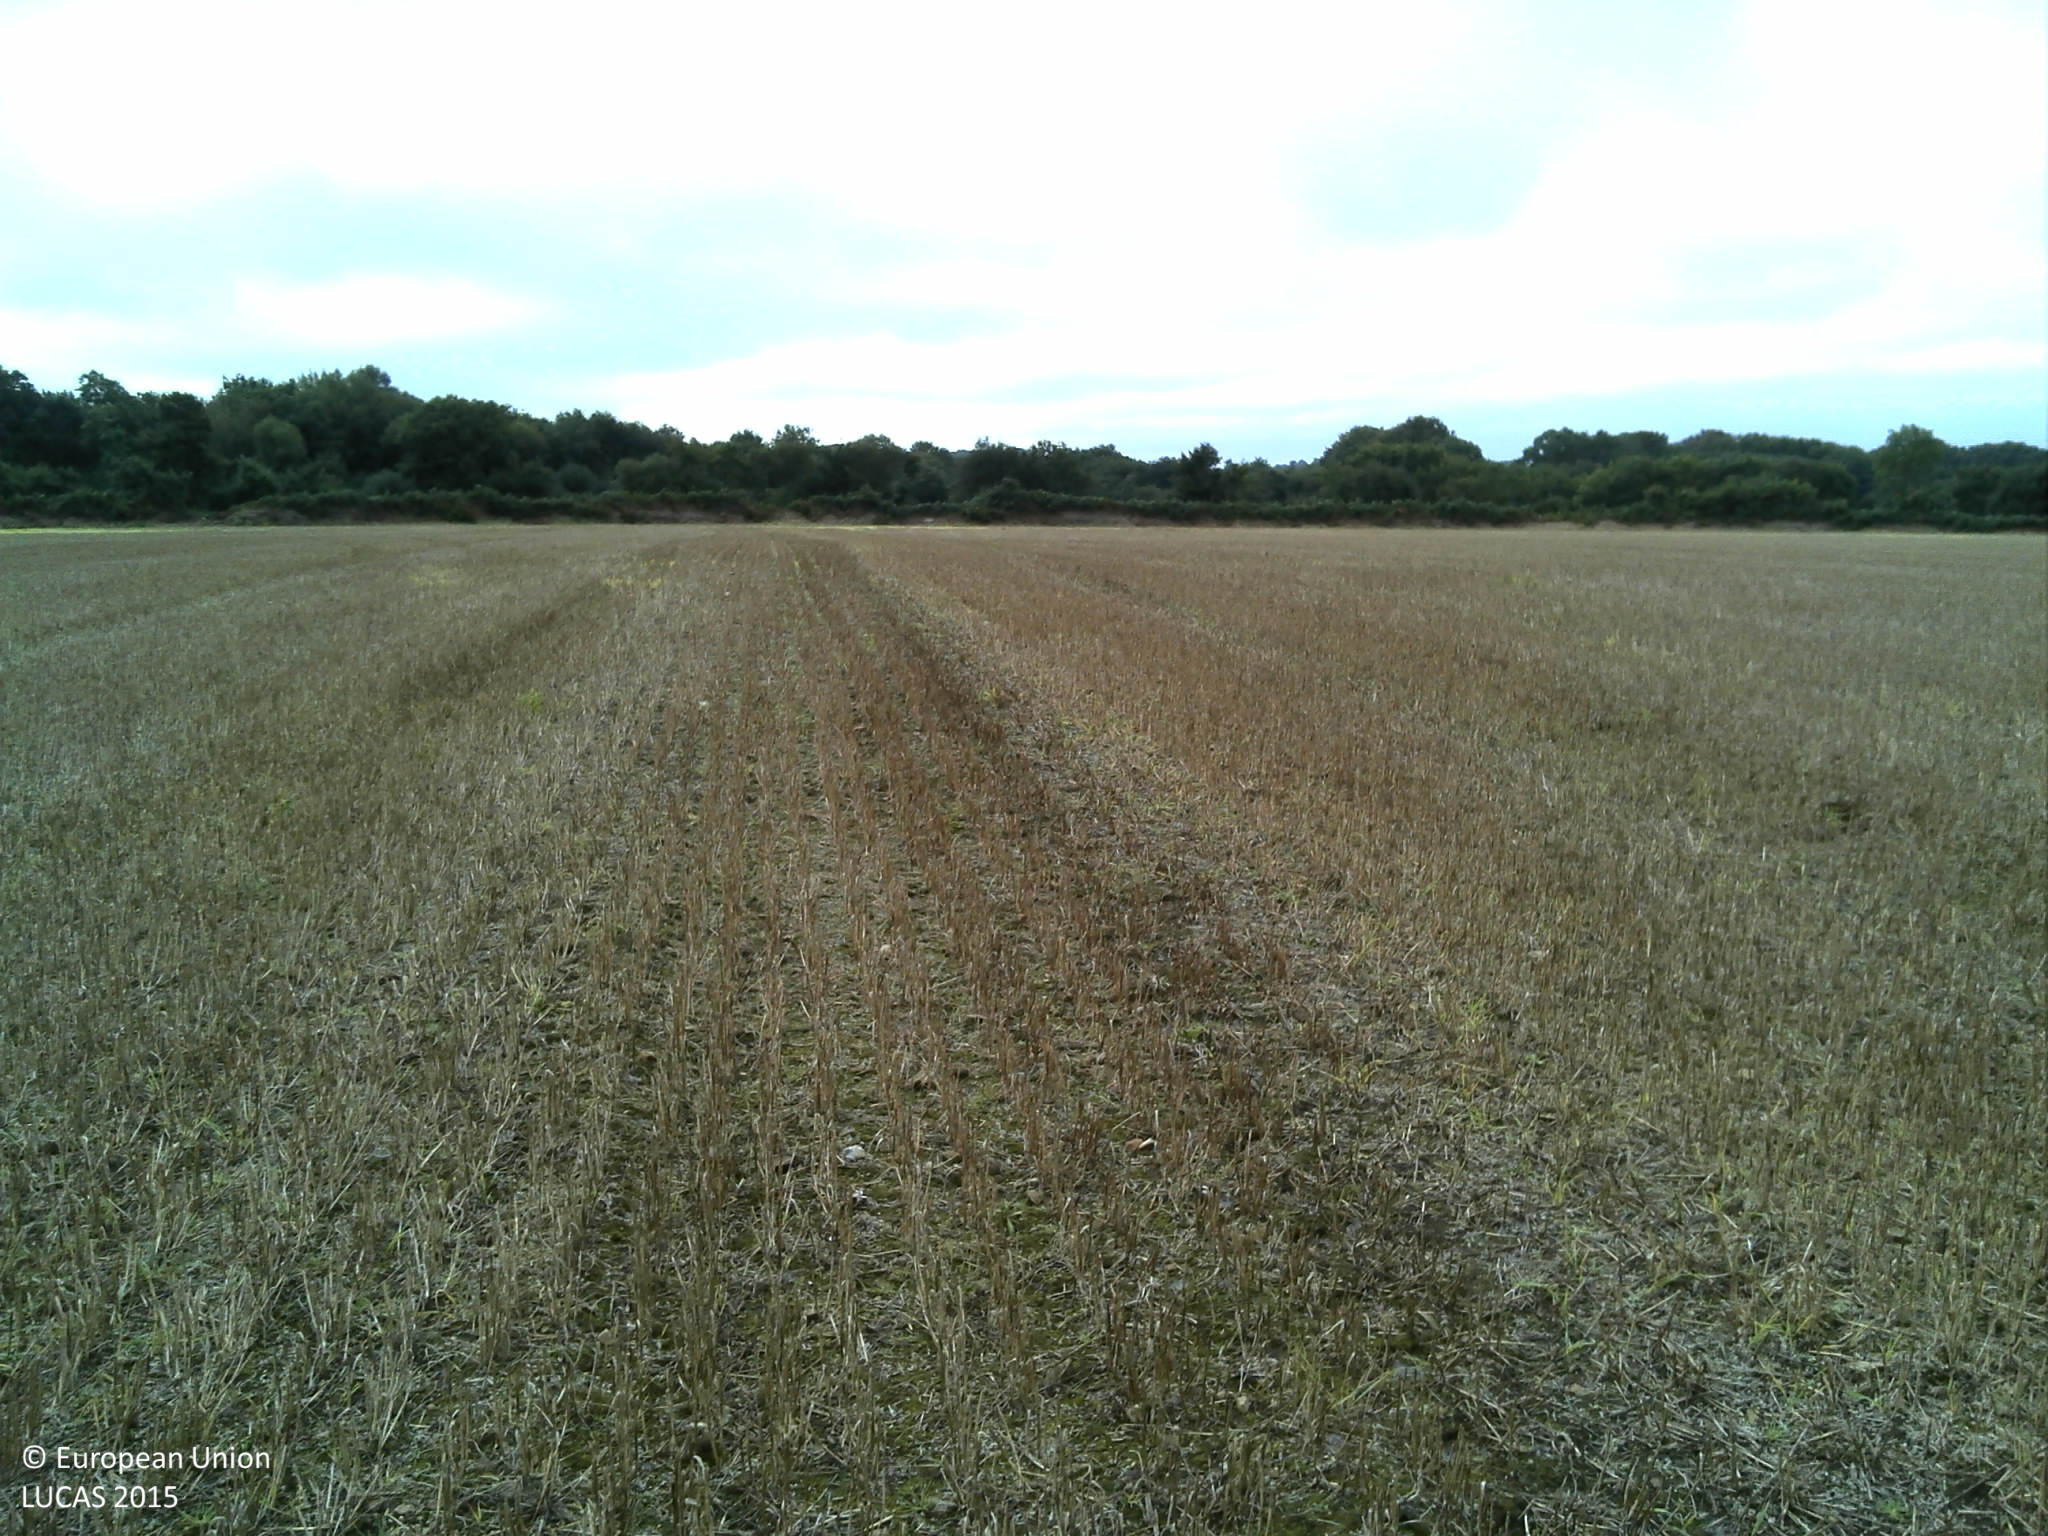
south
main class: Cropland
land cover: Common wheat
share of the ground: 50 - 75 %
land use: Agriculture (excluding fallow land and kitchen gardens)
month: September
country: FR
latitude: 48.5346
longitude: -4.2462
